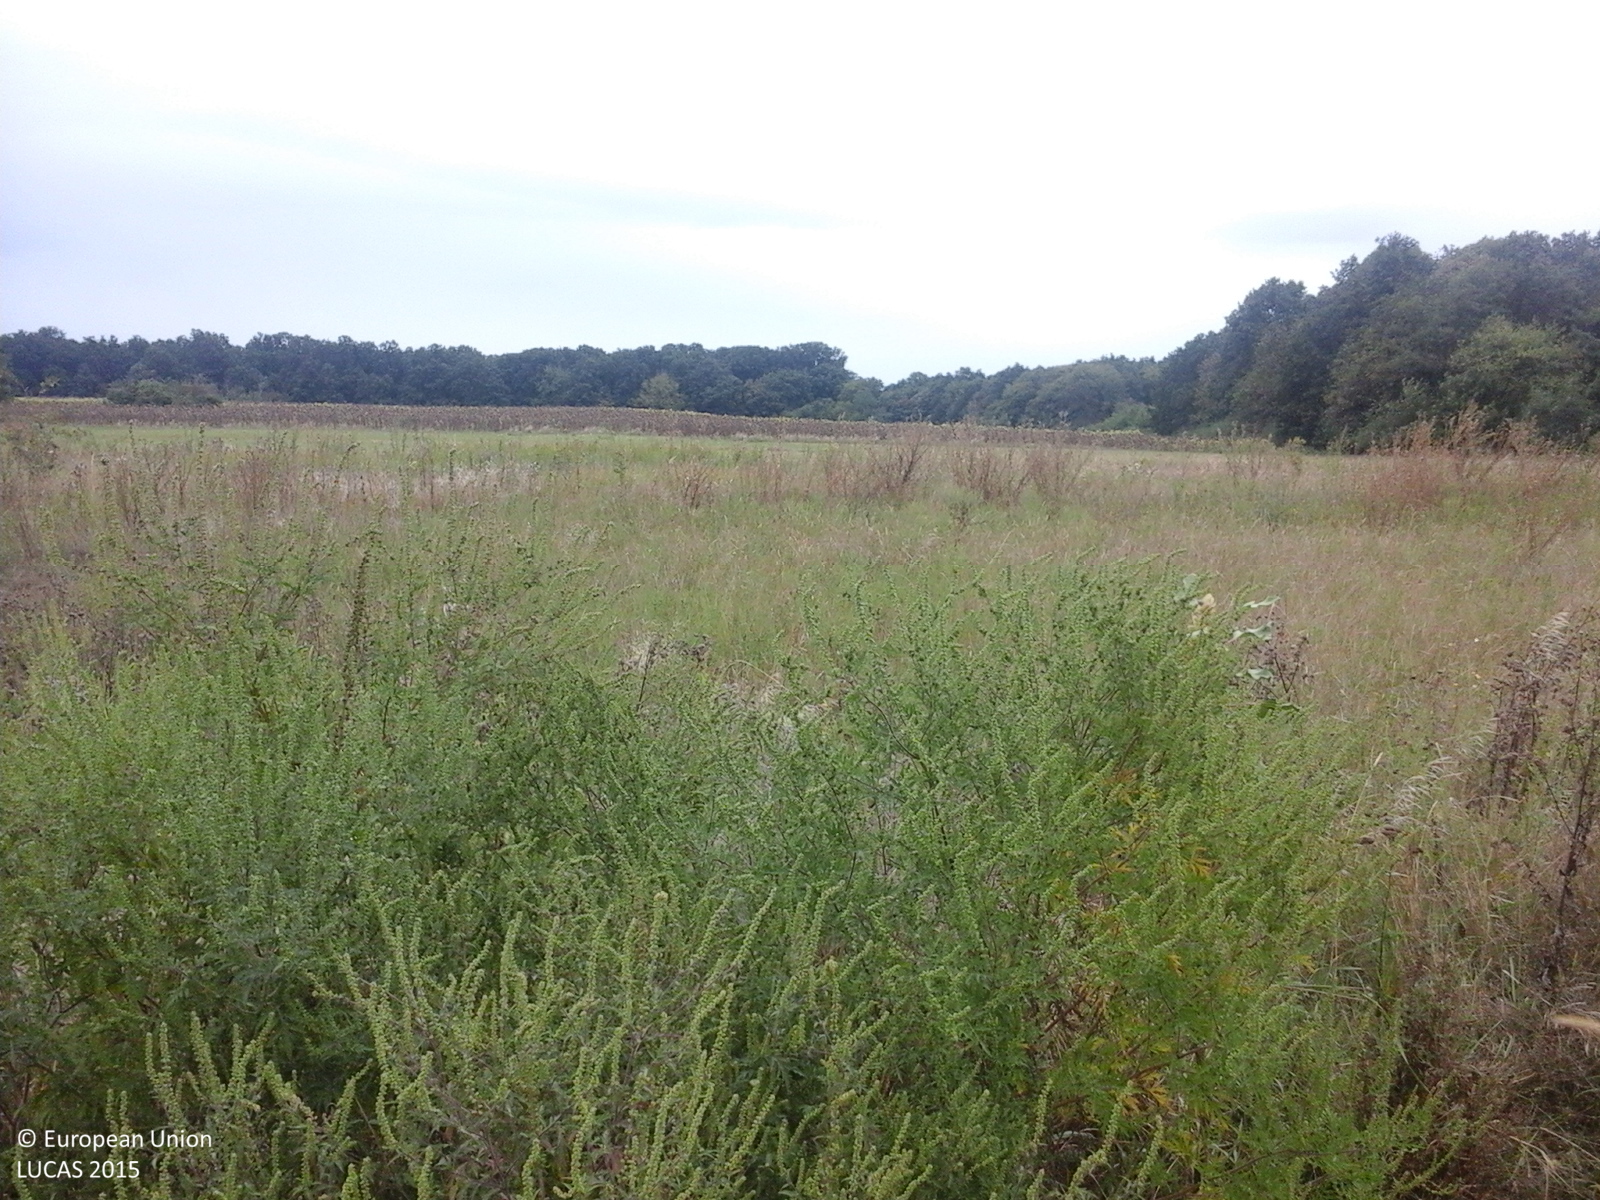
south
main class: Cropland
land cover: Sunflower
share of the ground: > 75 %
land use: Agriculture (excluding fallow land and kitchen gardens)
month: September
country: RO
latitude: 47.4412
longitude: 22.4545
